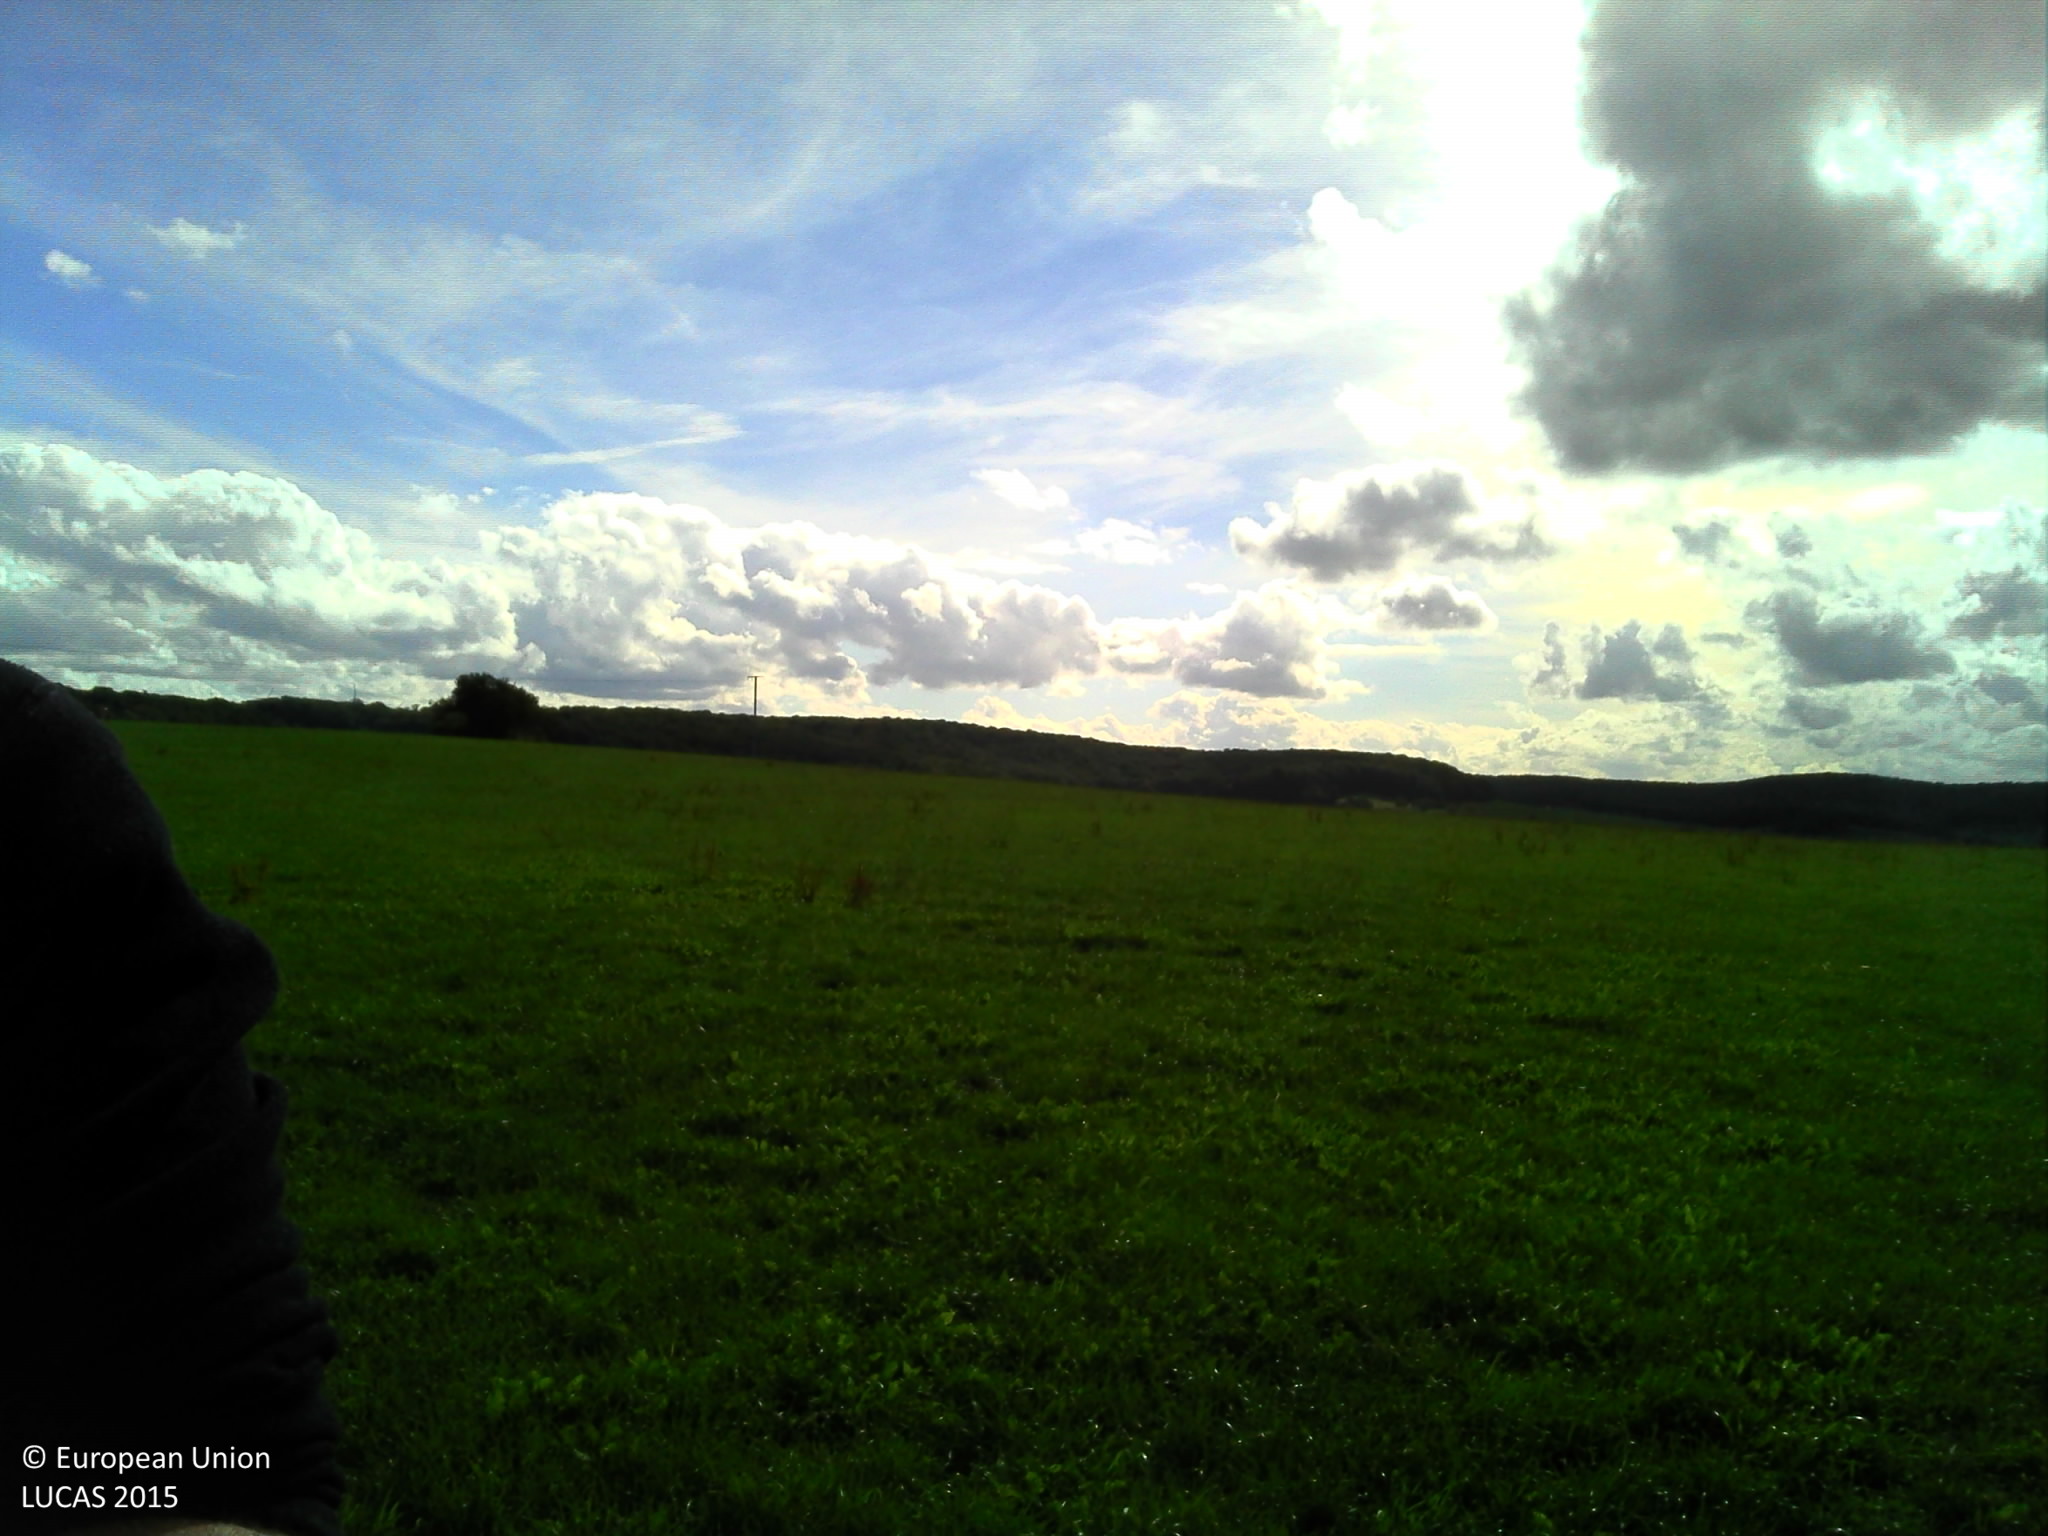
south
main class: Grassland
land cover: Grassland without tree/shrub cover
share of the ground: > 75 %
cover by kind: herbaceous plants 100 %
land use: Agriculture (excluding fallow land and kitchen gardens)
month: September
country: LU
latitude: 49.7872
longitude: 6.4578
